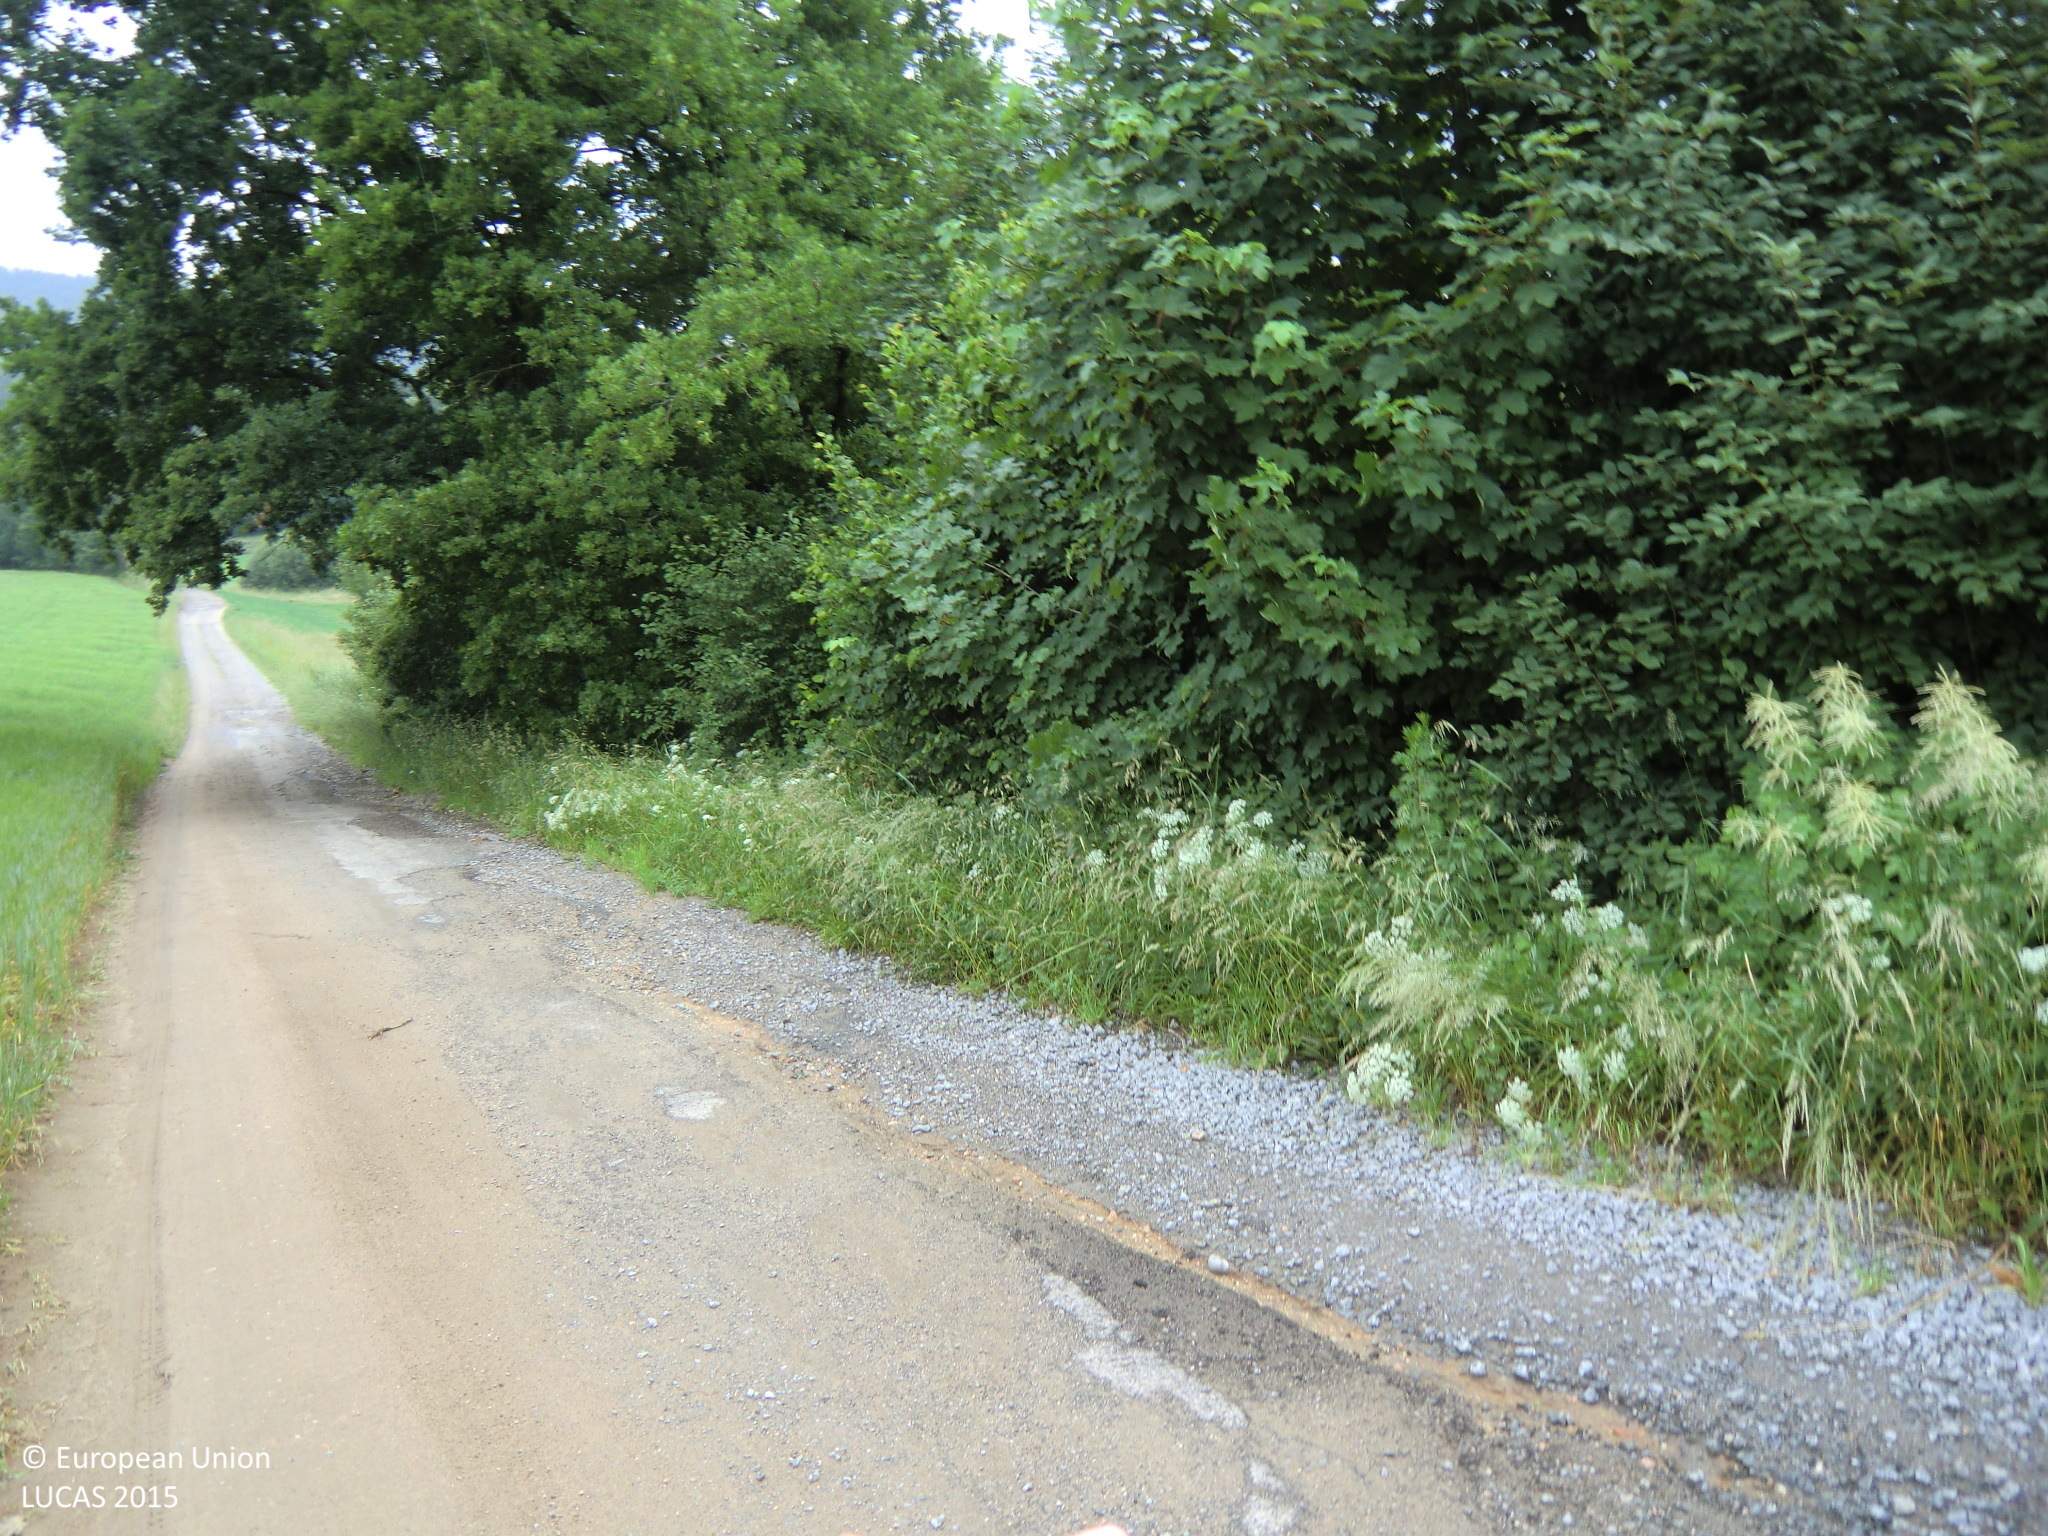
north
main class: Cropland
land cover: Rye
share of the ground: > 75 %
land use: Agriculture (excluding fallow land and kitchen gardens)
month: June
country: AT
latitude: 48.4717
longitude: 14.5591
